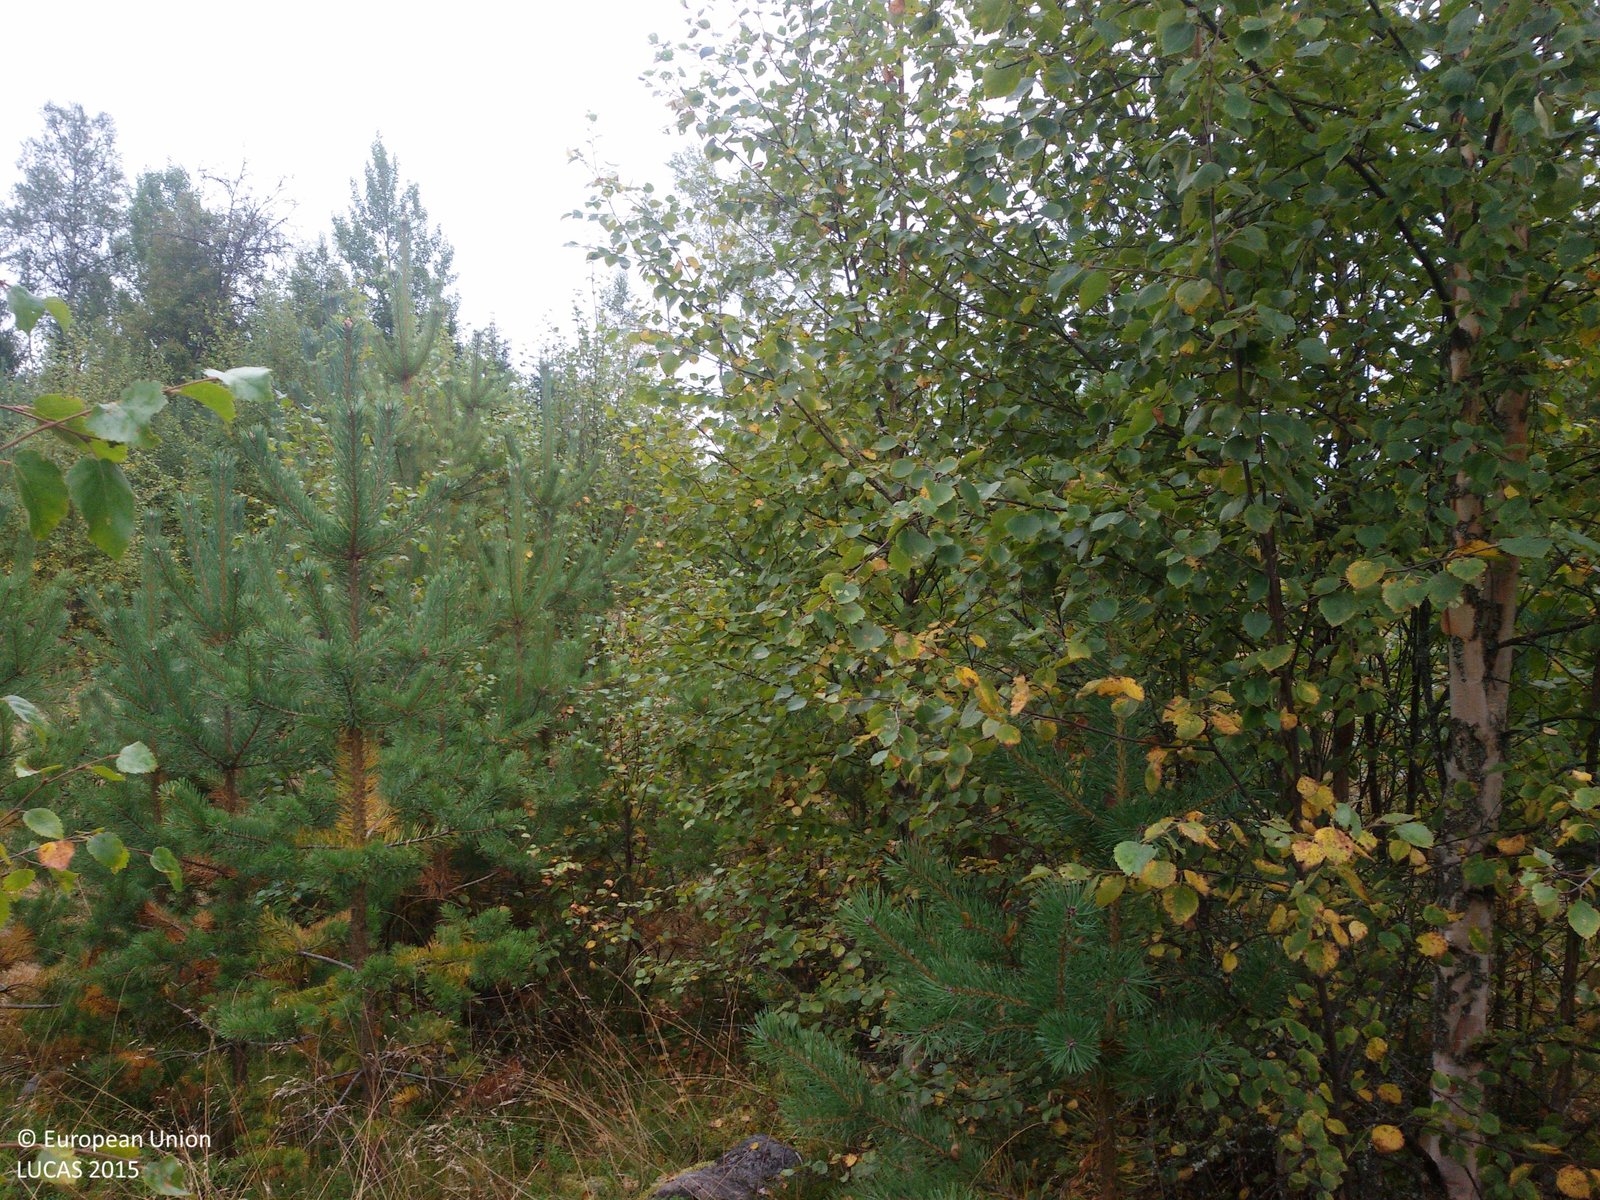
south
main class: Woodland
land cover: Pine dominated mixed woodland
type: boreal forest
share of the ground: 50 - 75 %
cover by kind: broadleaved forest trees 40 %, coniferous forest trees 30 %, herbaceous plants 20 %, lichens and mosses 10 %
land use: Forestry
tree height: < 5 m
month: September
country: SE
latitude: 60.8211
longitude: 15.3006
